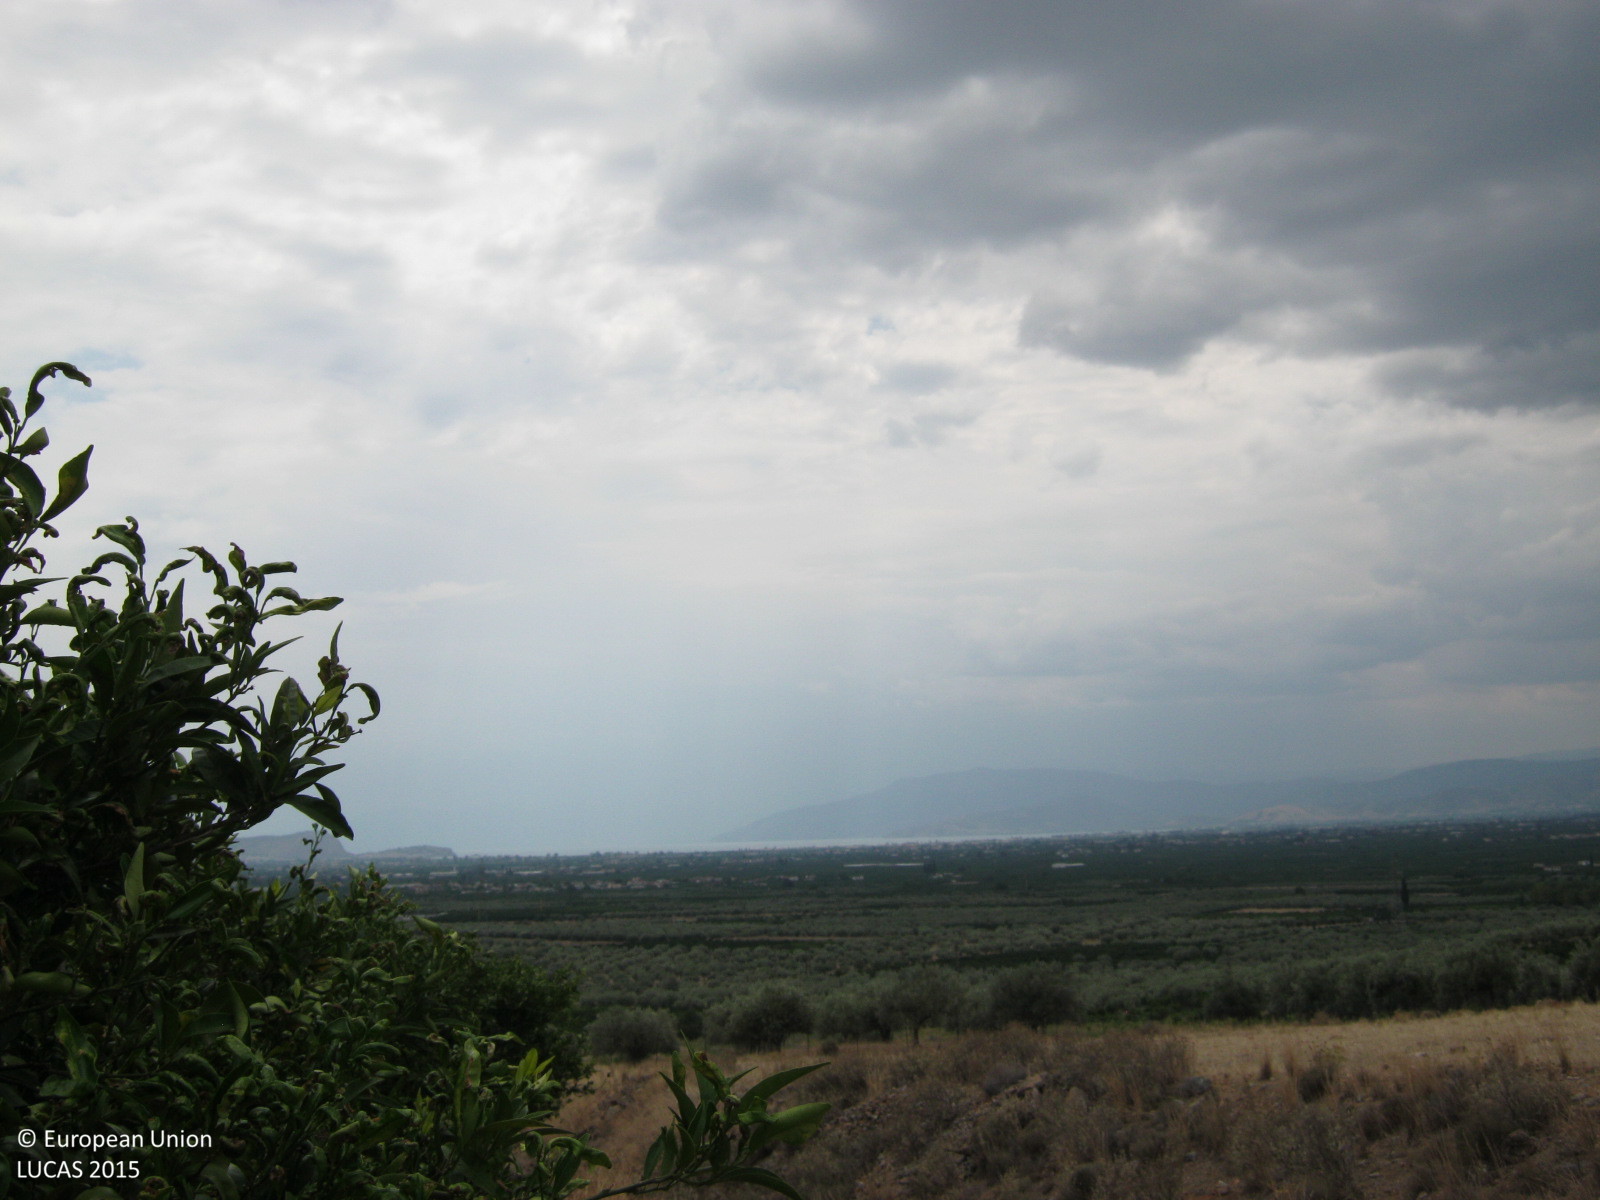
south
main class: Cropland
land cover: Oranges
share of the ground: > 75 %
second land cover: Spontaneously vegetated surfaces
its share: 50 - 75 %
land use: Agriculture (excluding fallow land and kitchen gardens)
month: August
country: GR
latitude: 37.6864
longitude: 22.7927
